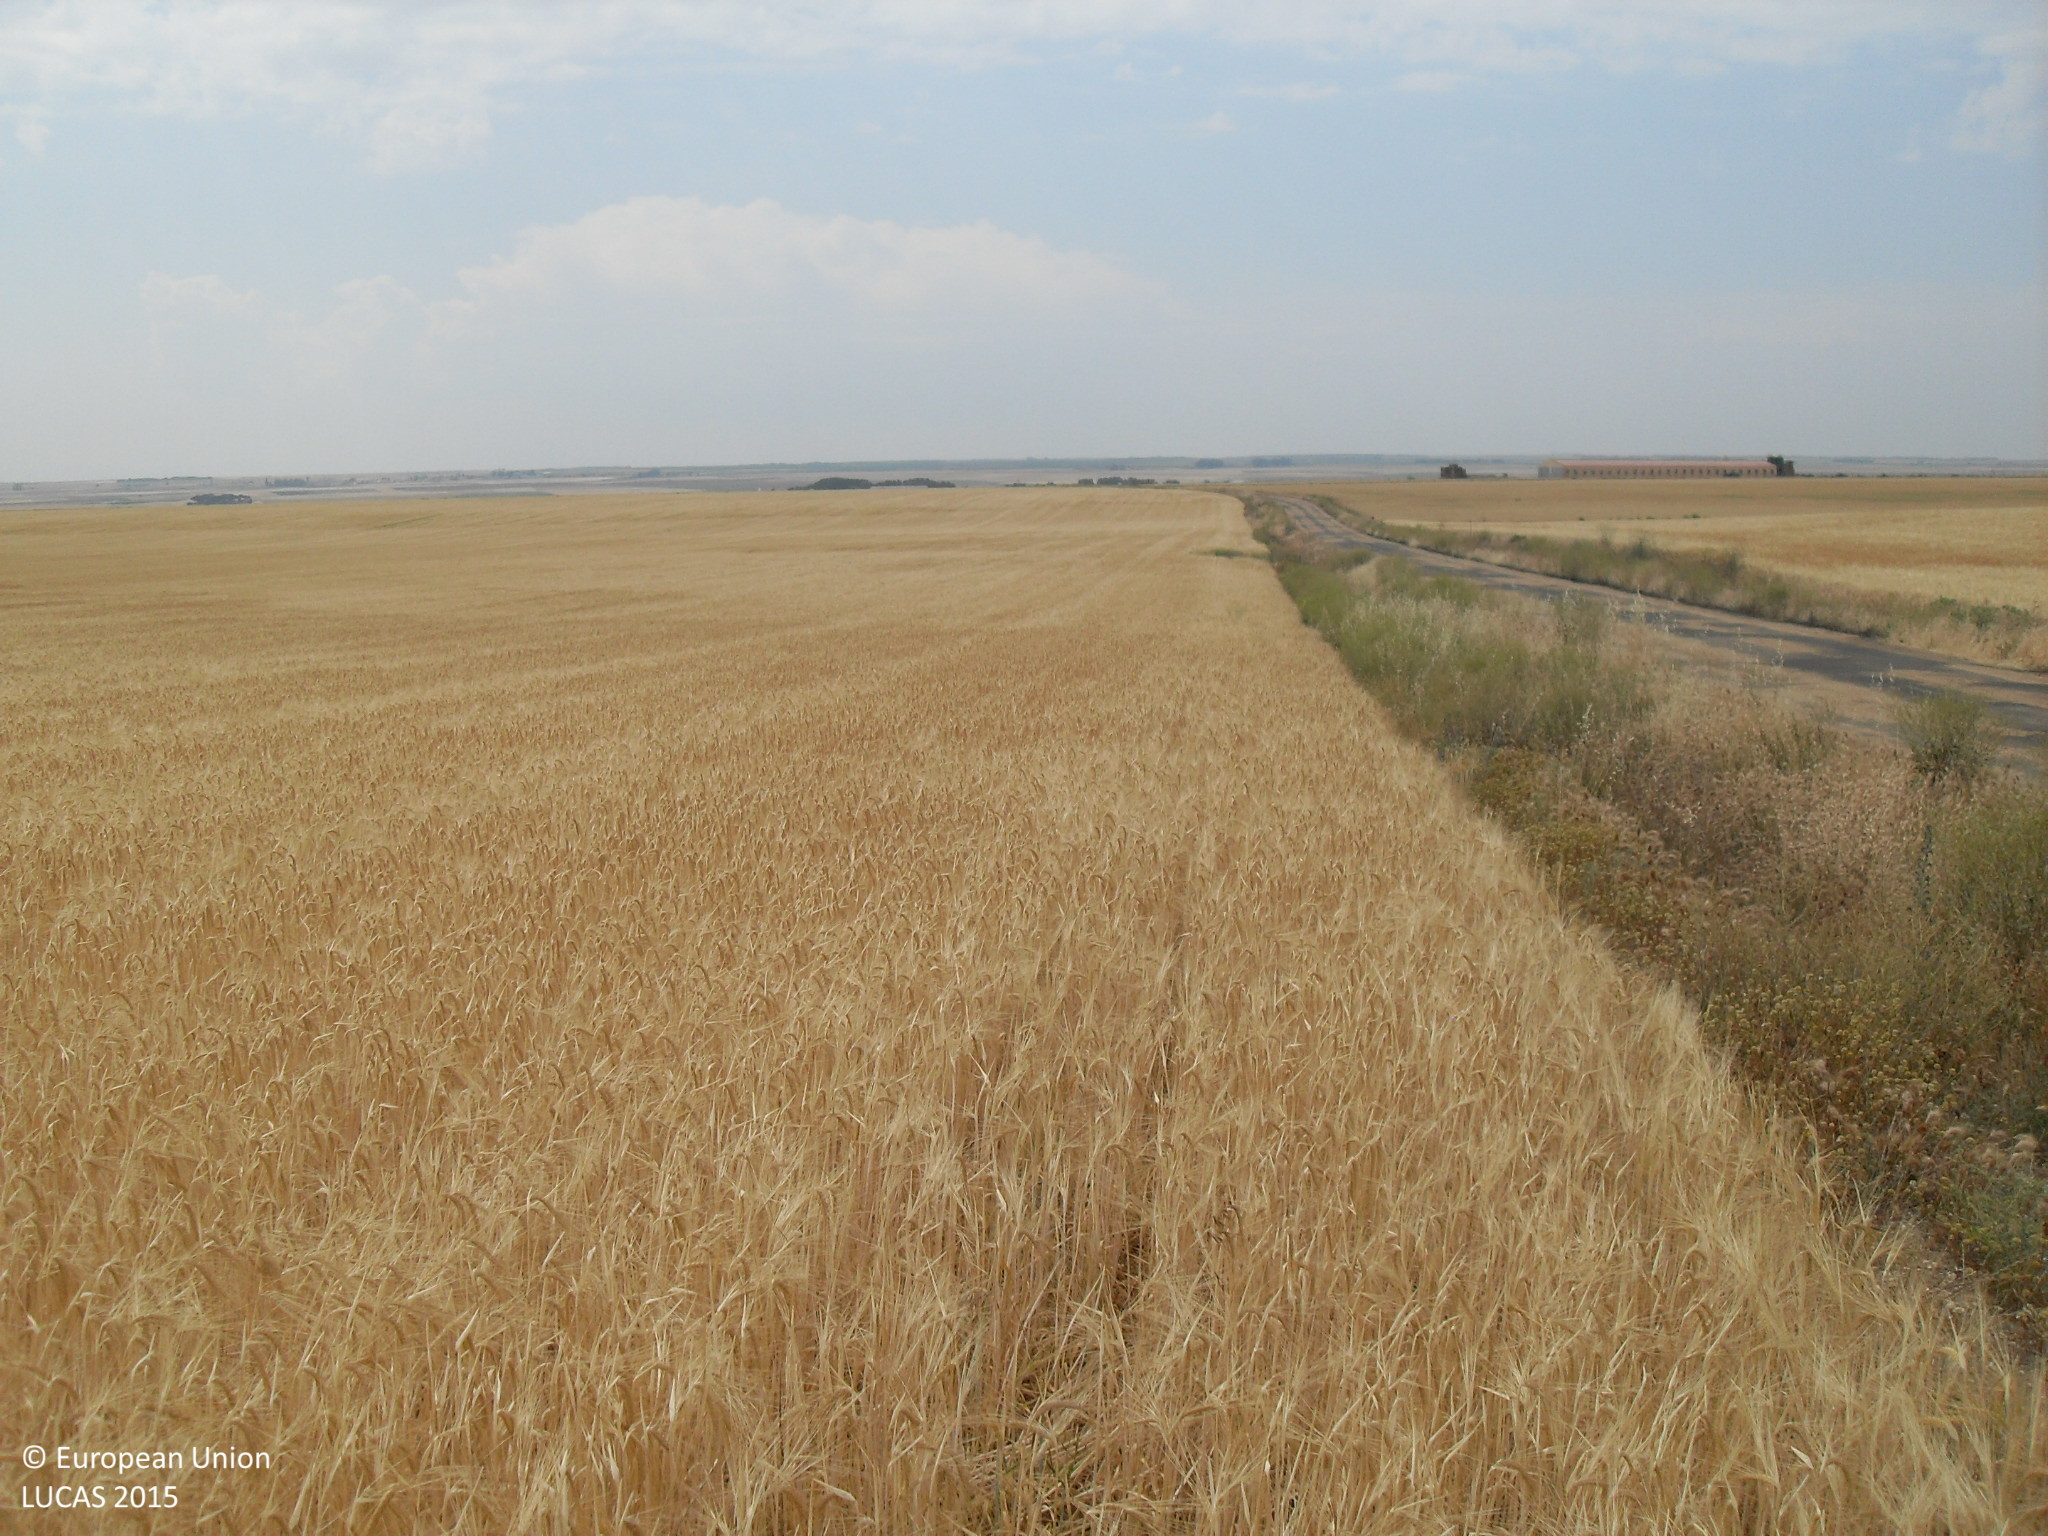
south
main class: Cropland
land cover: Barley
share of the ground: > 75 %
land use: Agriculture (excluding fallow land and kitchen gardens)
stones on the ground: < 10 %
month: June
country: ES
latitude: 41.1329
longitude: -5.4302
